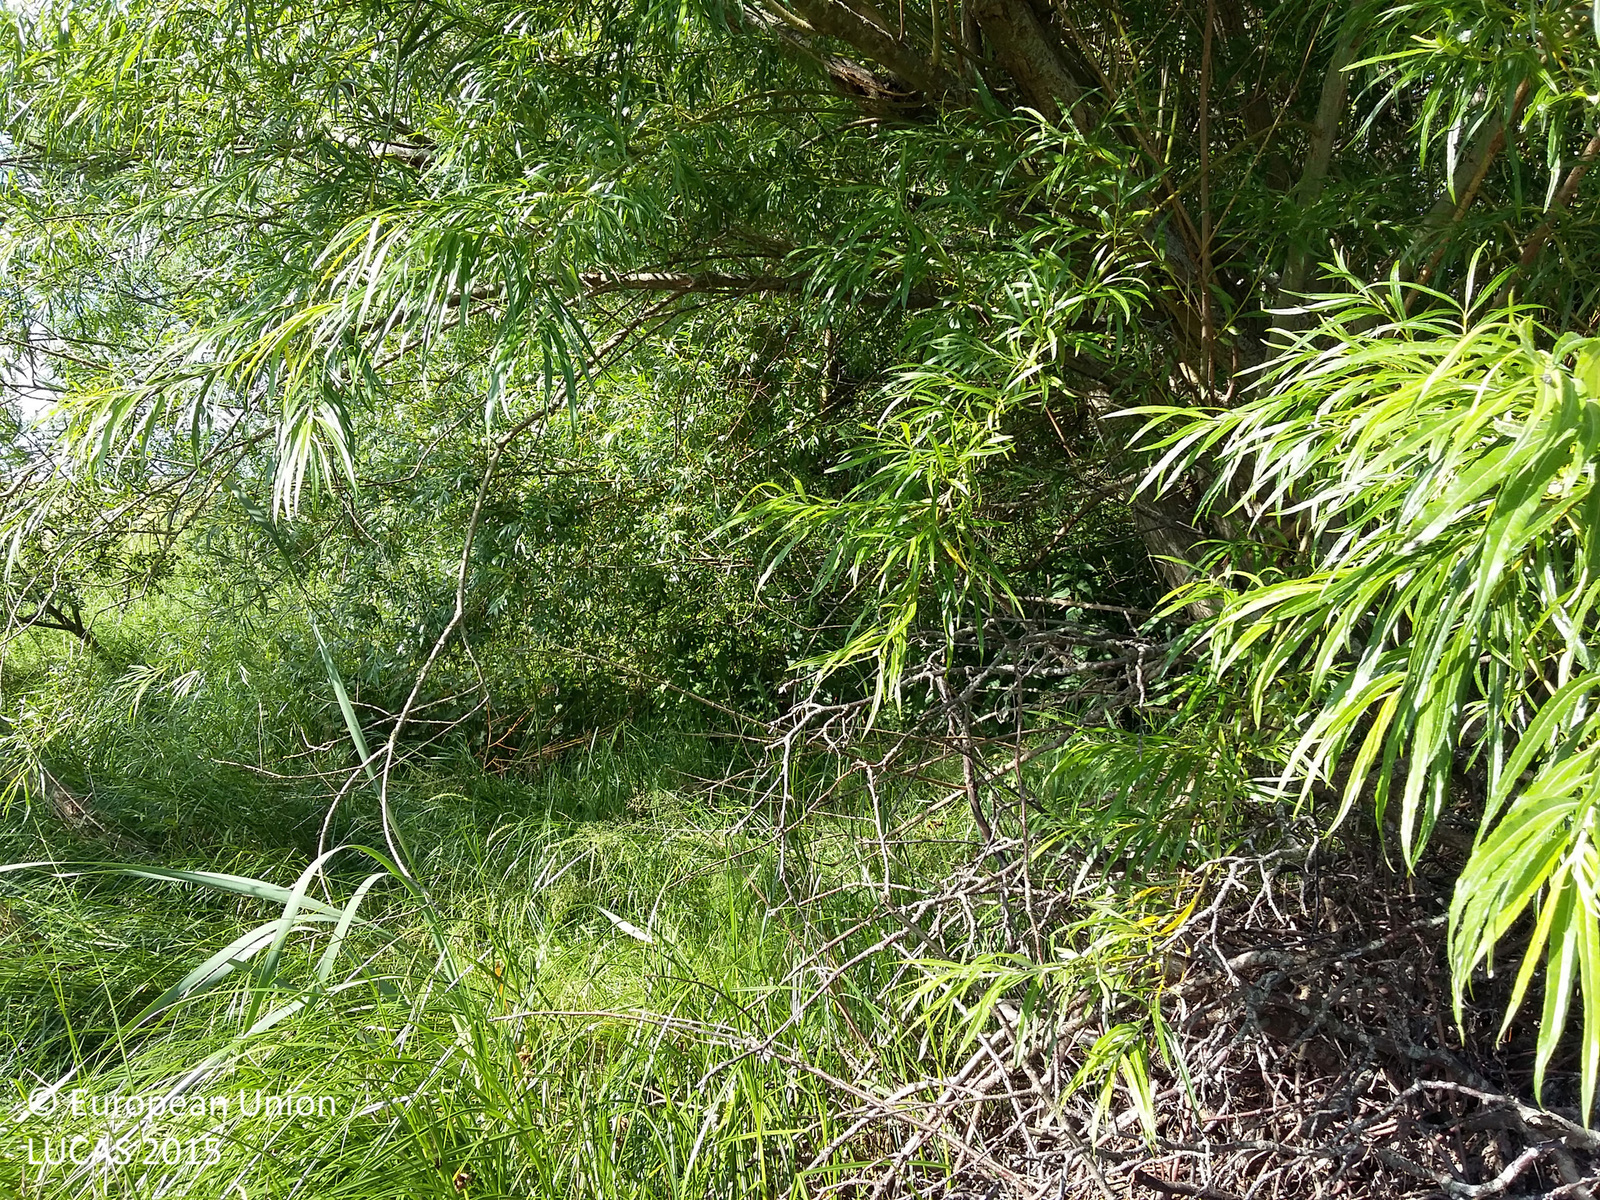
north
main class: Woodland
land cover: Broadleaved woodland
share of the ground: > 75 %
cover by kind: broadleaved forest trees 80 %, herbaceous plants 20 %
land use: Semi-natural and natural areas not in use
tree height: > 5 m
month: July
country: DK
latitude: 55.8013
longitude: 11.5140
